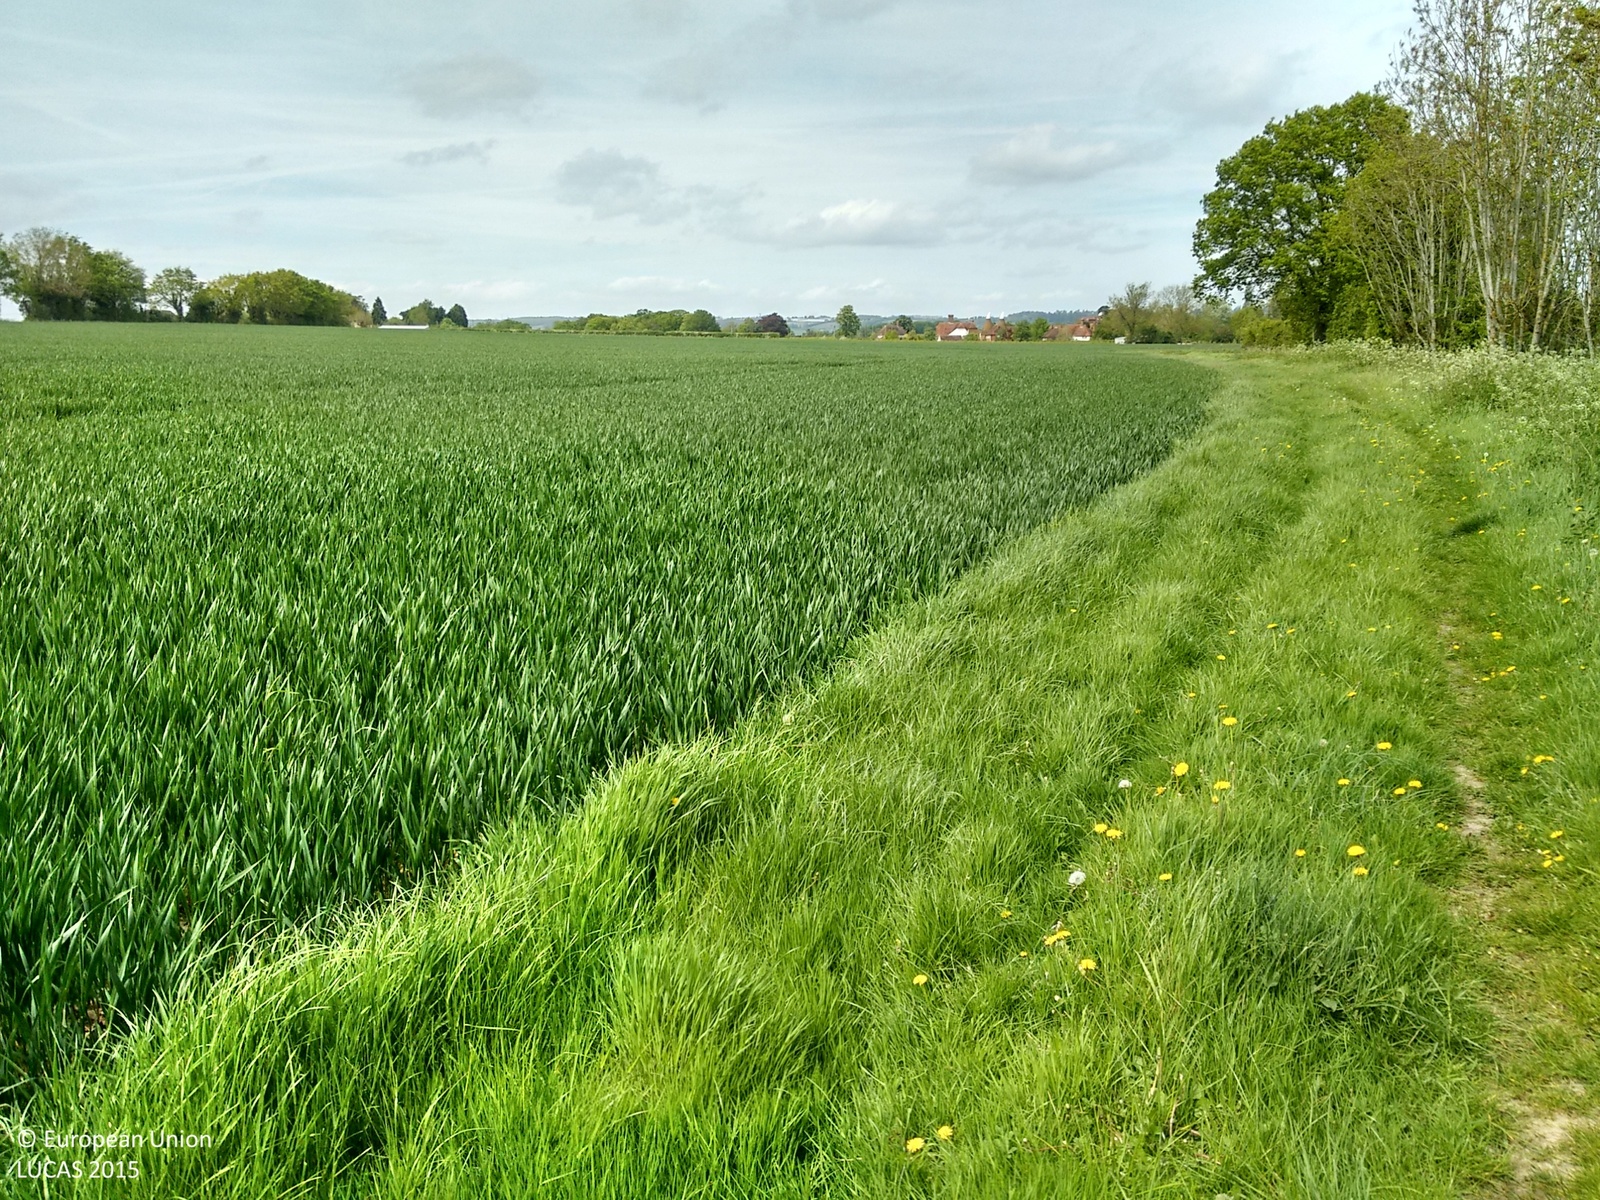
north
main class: Cropland
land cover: Barley
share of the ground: > 75 %
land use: Agriculture (excluding fallow land and kitchen gardens)
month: May
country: GB
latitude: 51.1823
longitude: 0.5160
